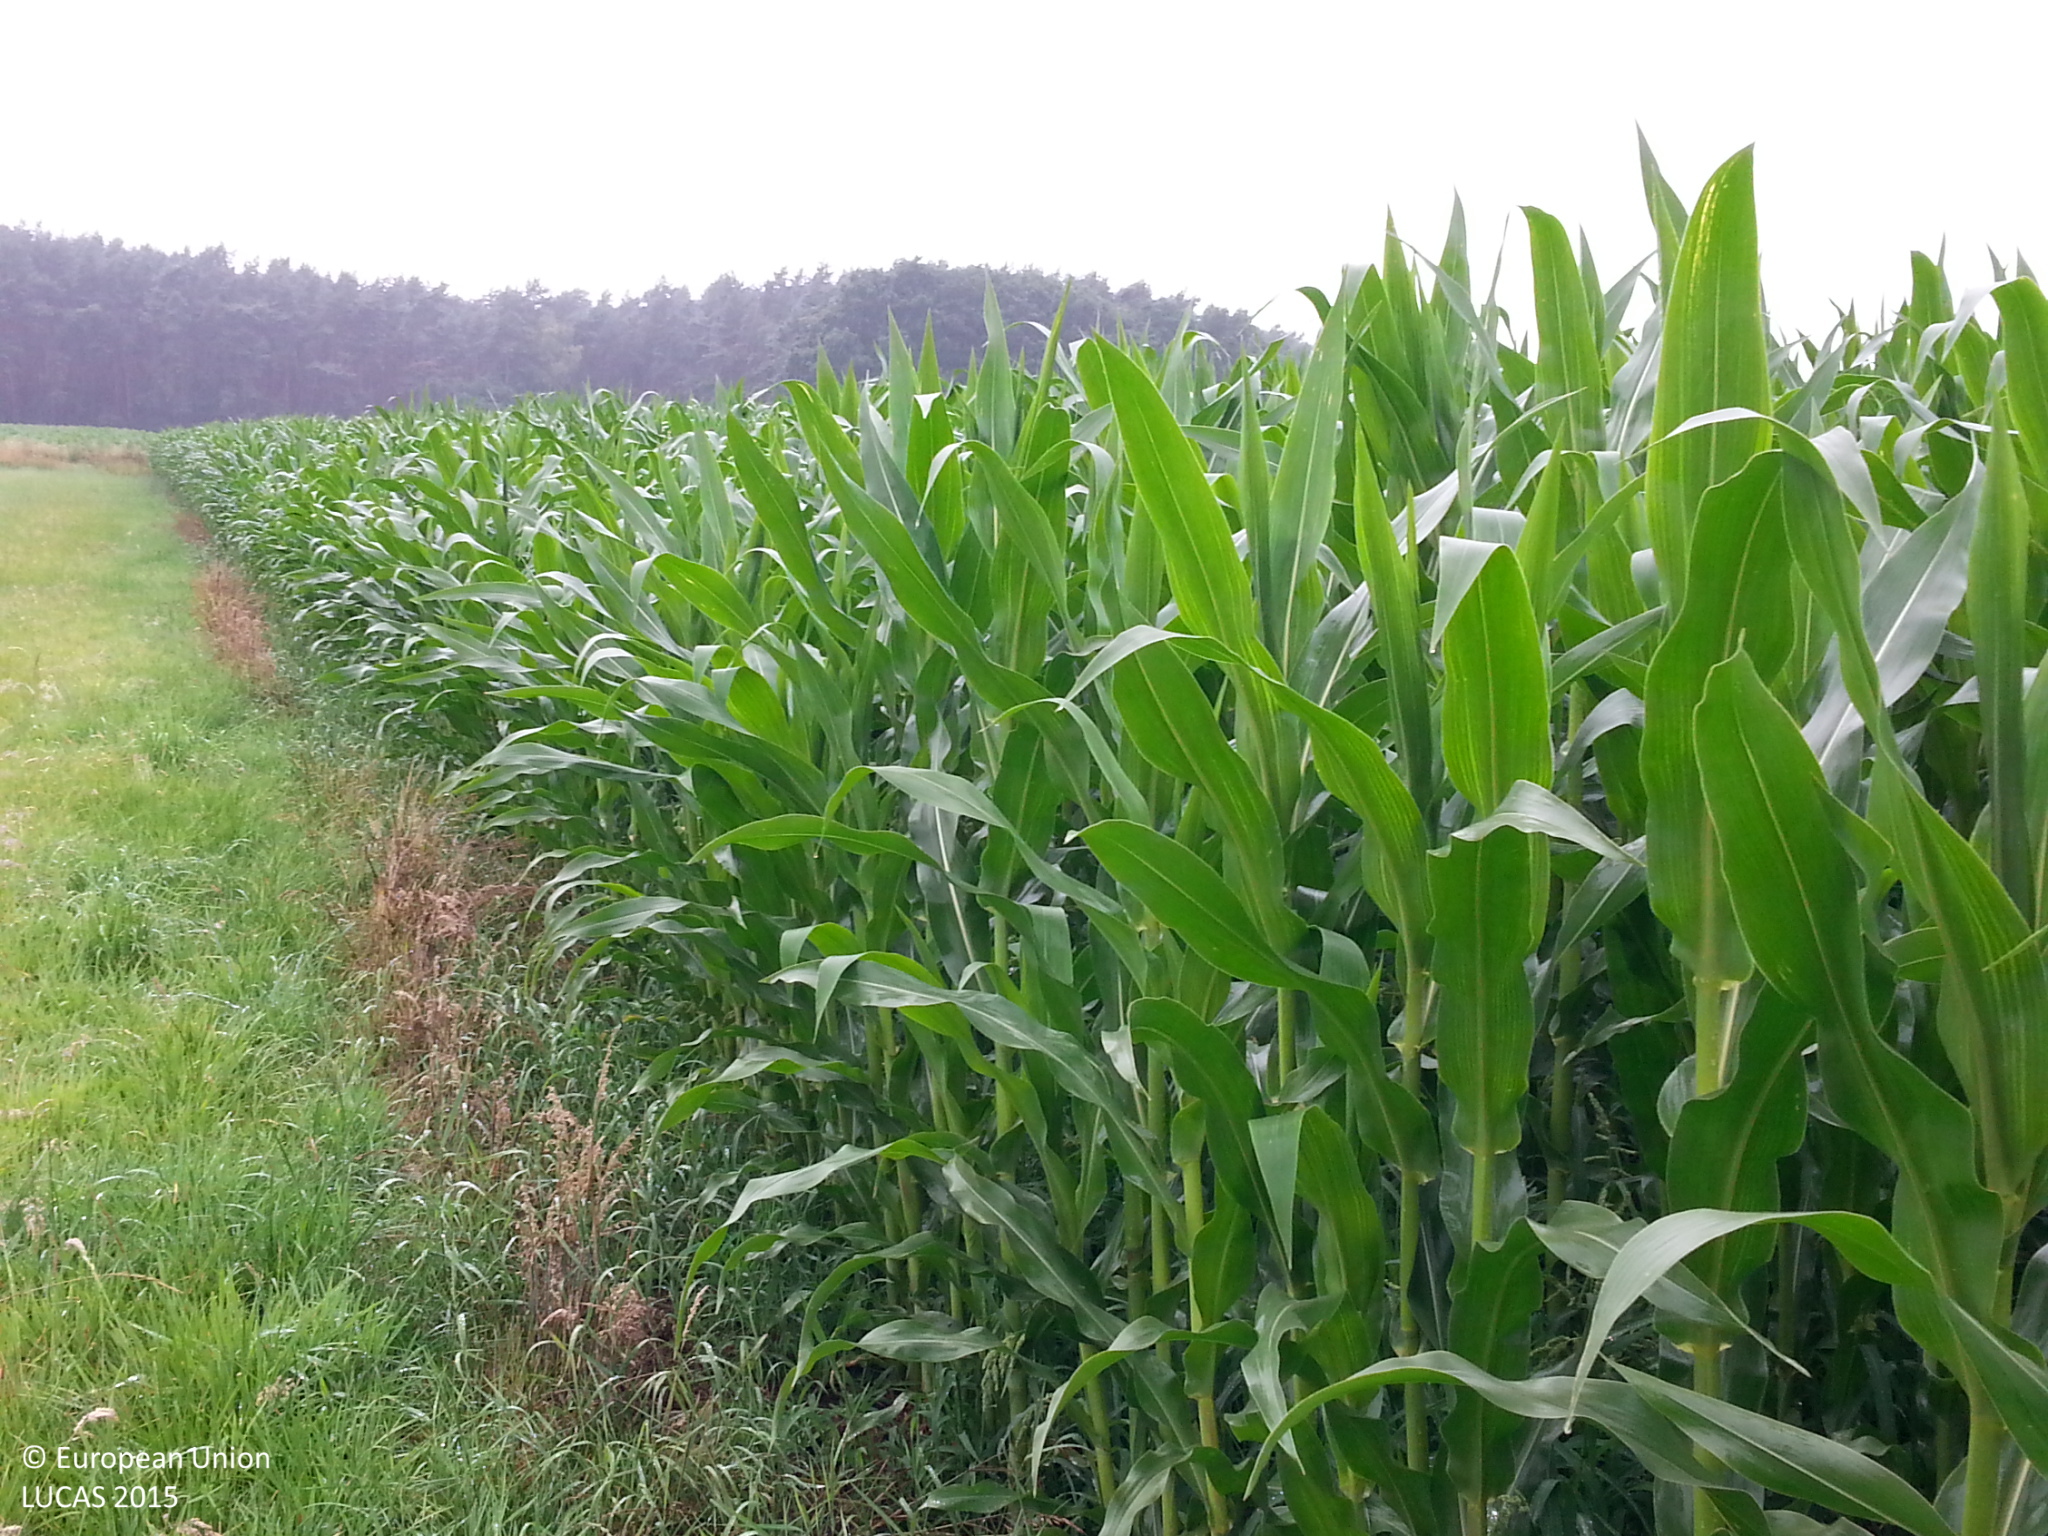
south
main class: Cropland
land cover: Maize
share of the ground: > 75 %
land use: Agriculture (excluding fallow land and kitchen gardens)
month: July
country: DE
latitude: 52.9836
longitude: 11.0869
